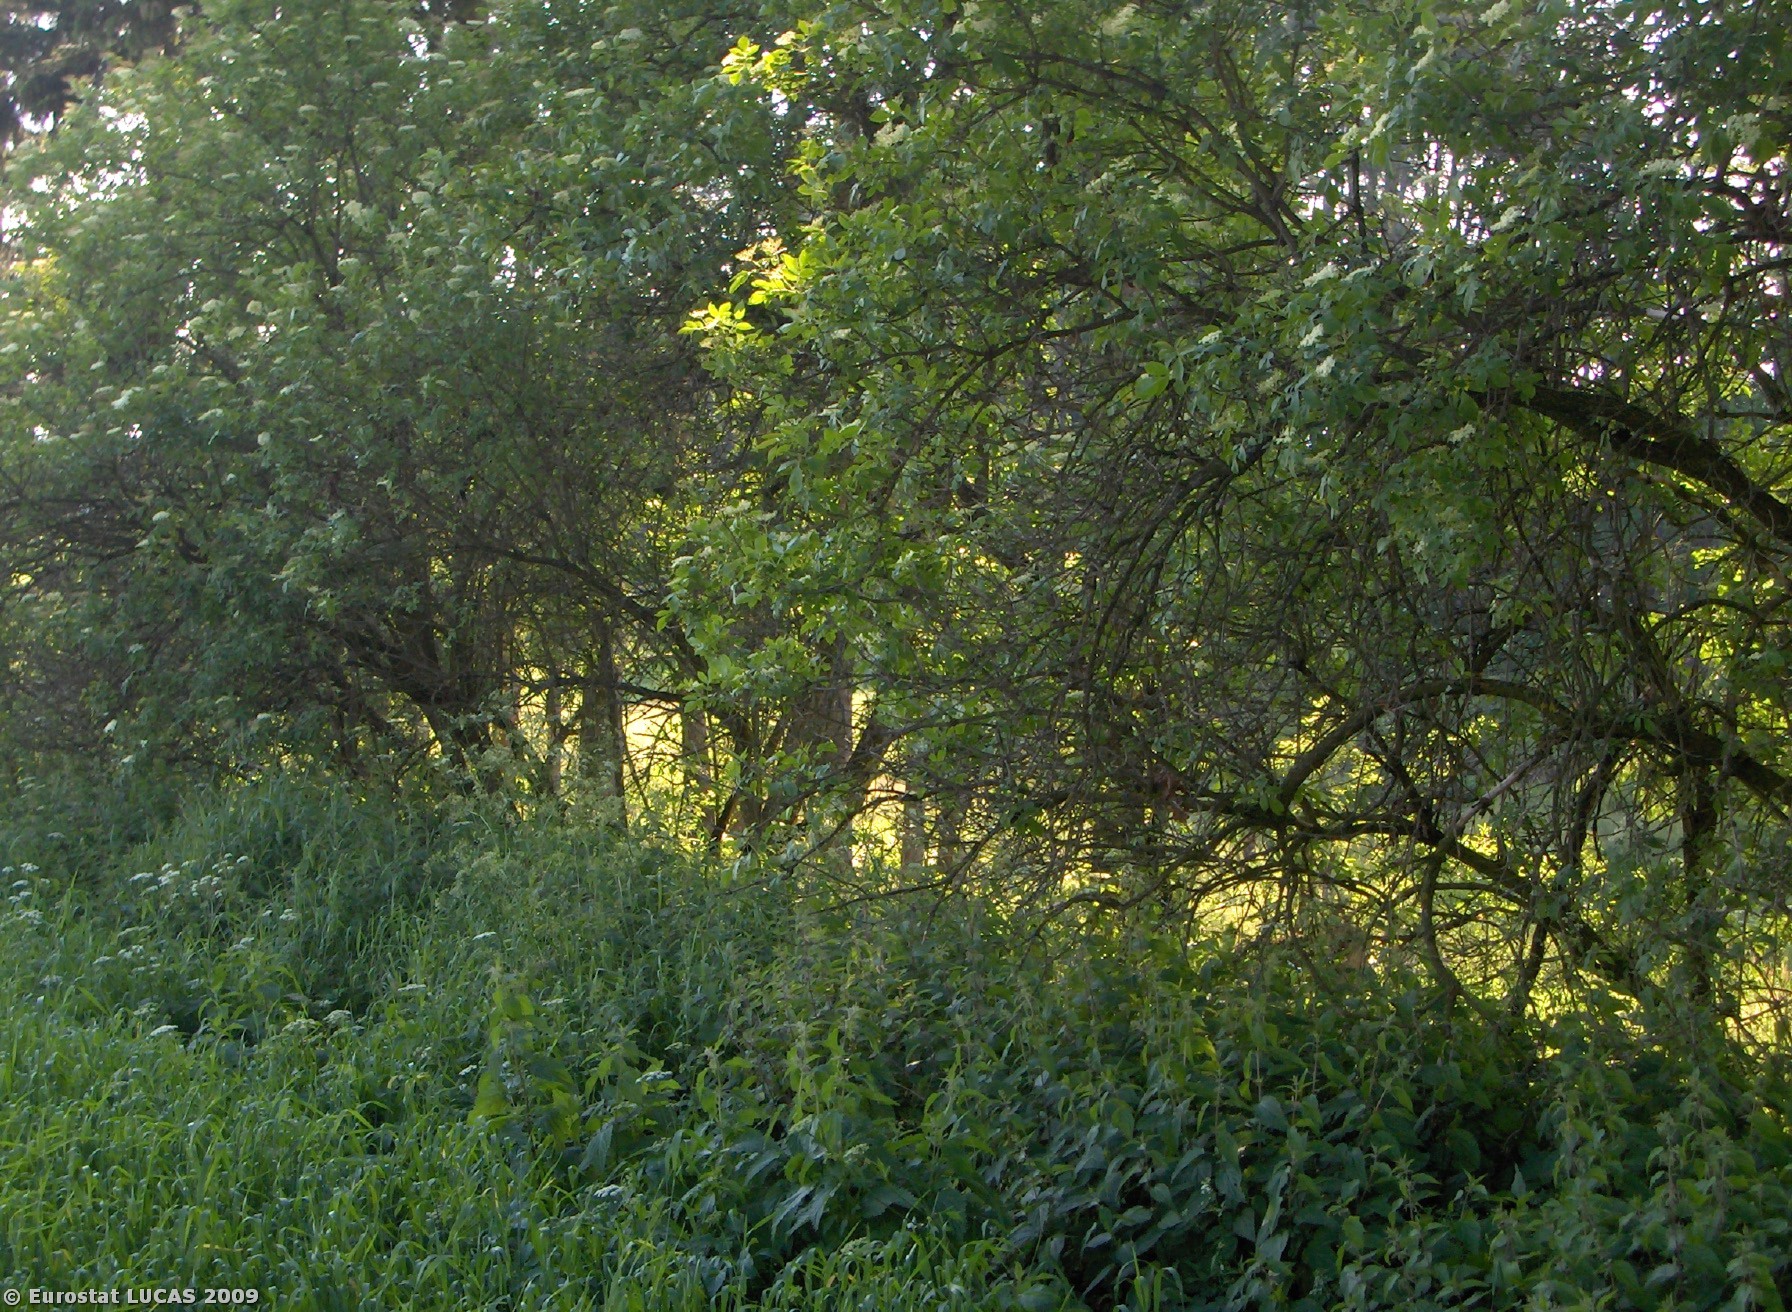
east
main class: Cropland
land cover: Barley
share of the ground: > 75 %
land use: Agriculture (excluding fallow land and kitchen gardens)
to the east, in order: Barley; Mixed woodland; Spontaneously vegetated surfaces; Ditches and canals; Spontaneously vegetated surfaces; Electric lines; Shrubland with sparse tree cover; Mixed woodland; Tracks; Barley
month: June
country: CZ
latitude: 49.1658
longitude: 14.3211
